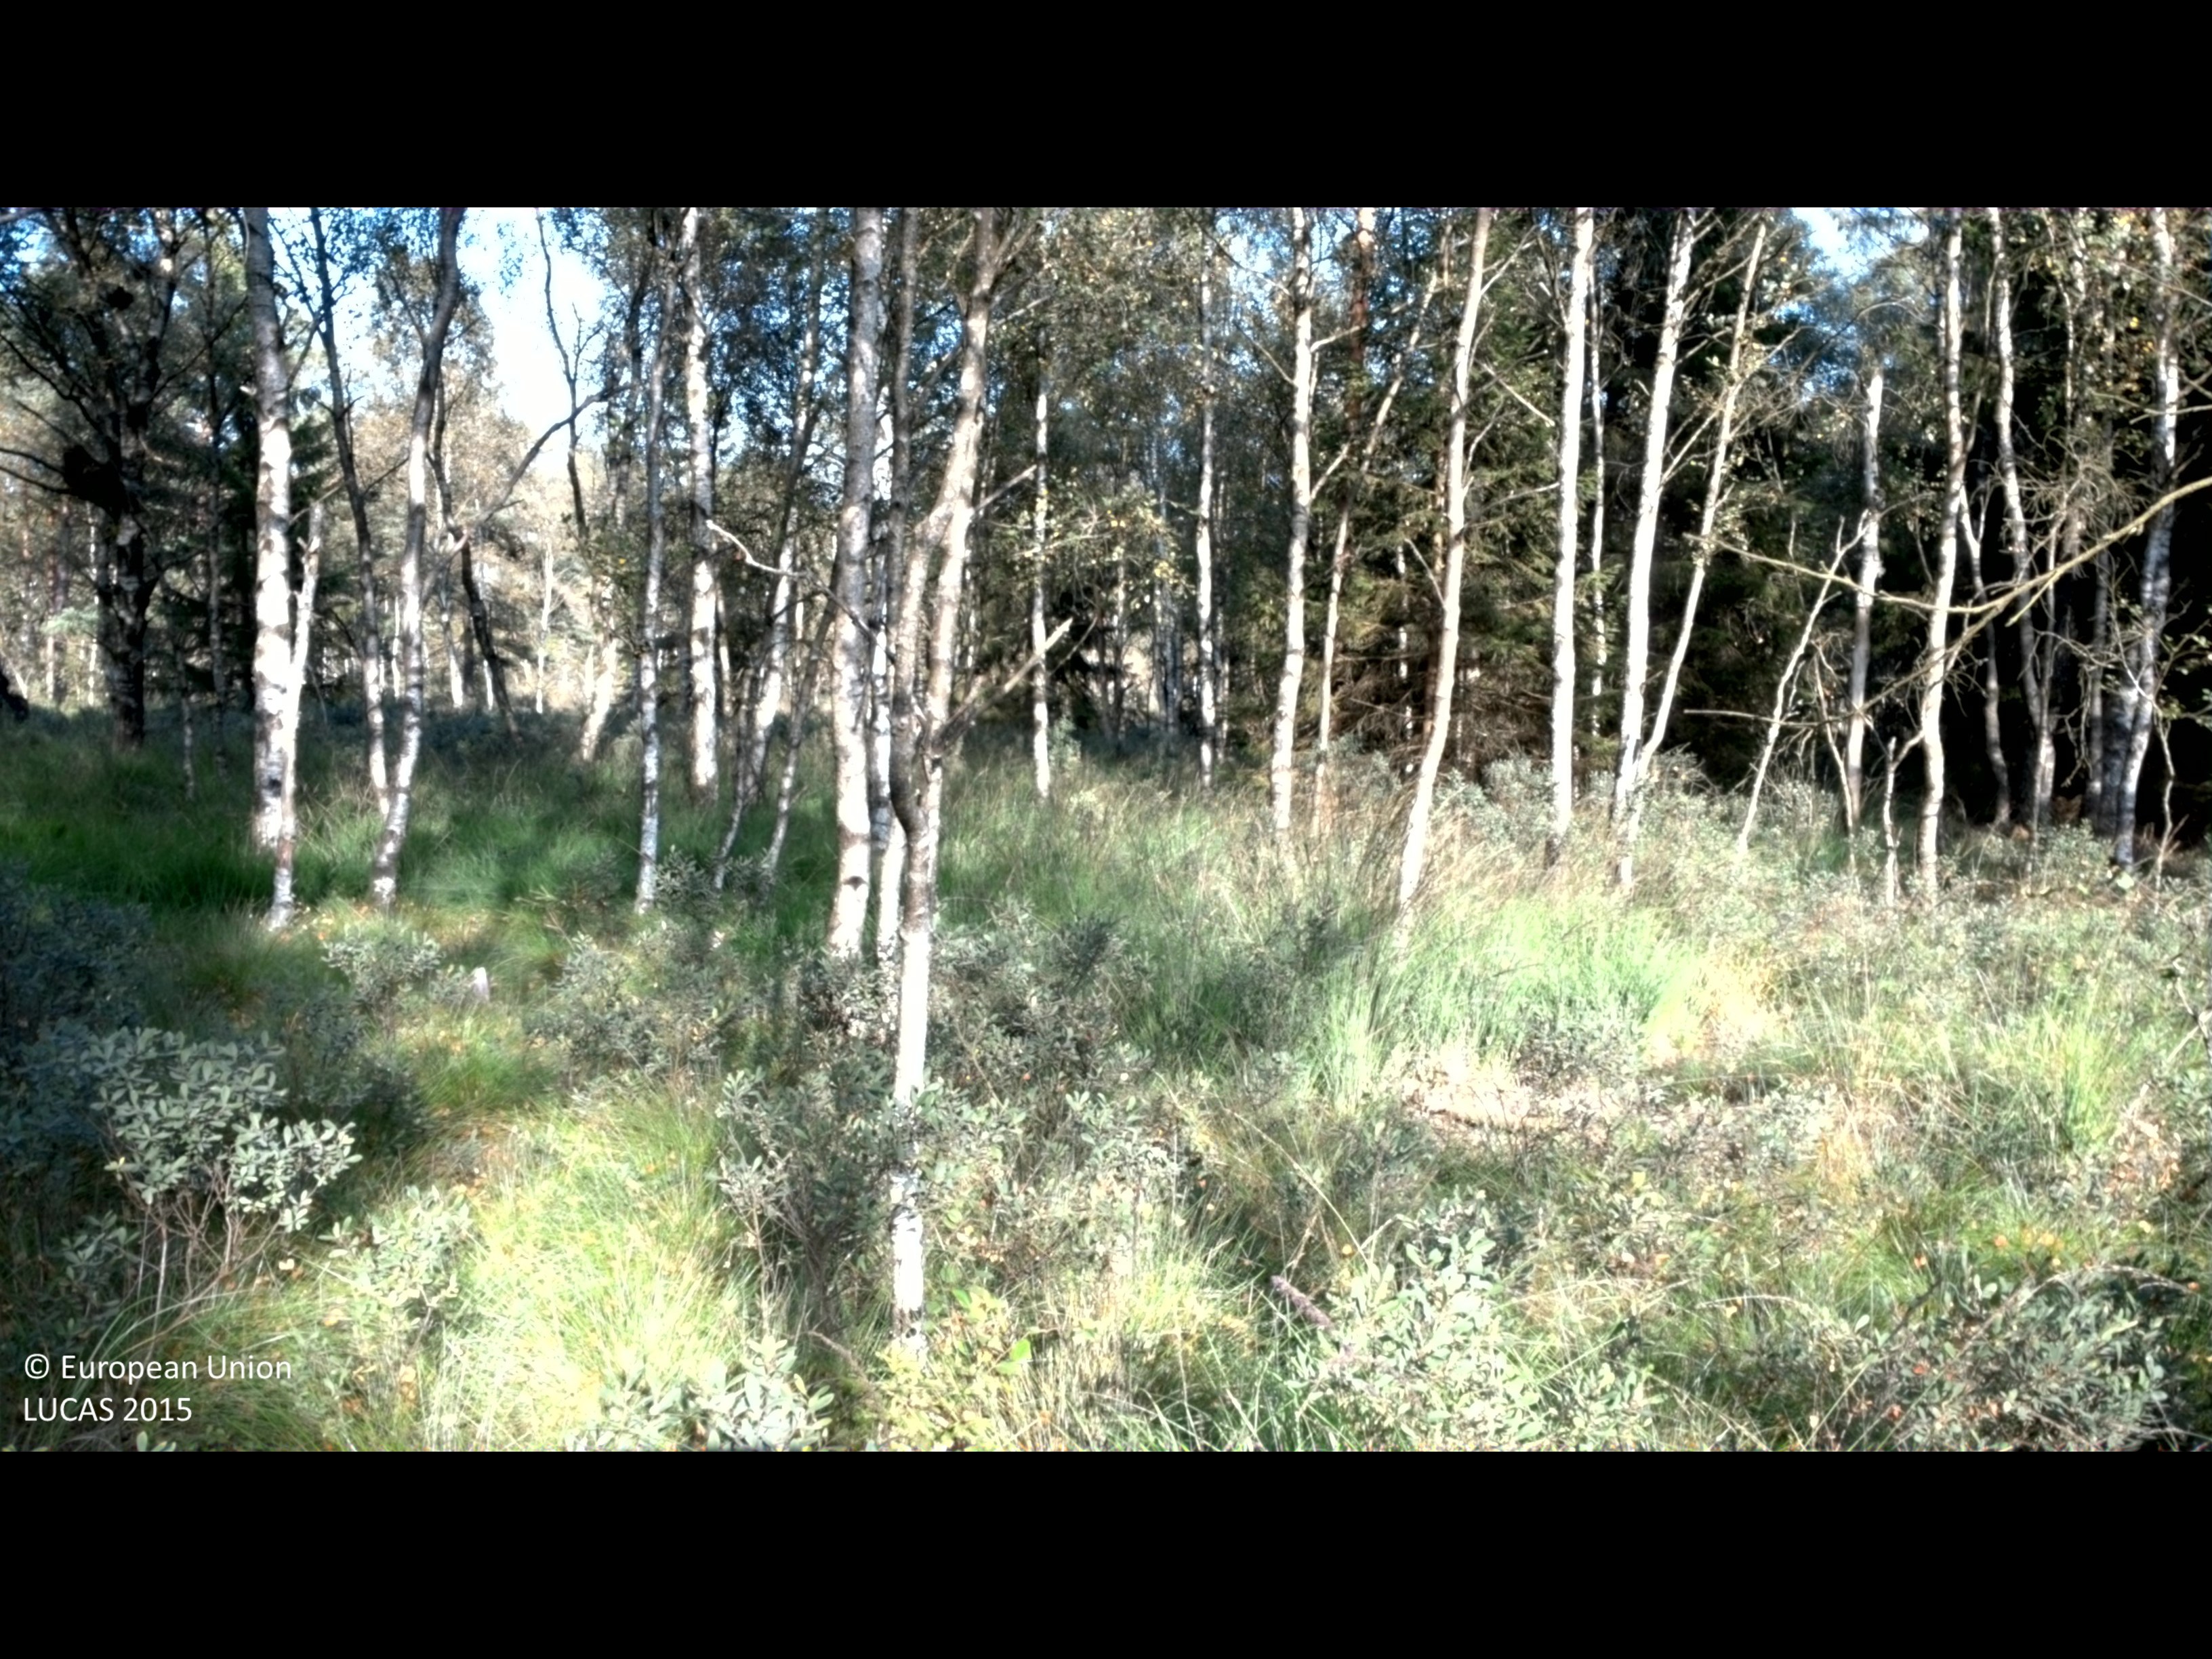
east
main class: Woodland
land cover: Pine dominated mixed woodland
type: boreal forest
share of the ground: 50 - 75 %
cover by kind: broadleaved forest trees 40 %, shrubs 25 %, herbaceous plants 20 %, coniferous forest trees 15 %
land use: Semi-natural and natural areas not in use
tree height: > 5 m
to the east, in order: Pine dominated mixed woodland; Spruce dominated mixed woodland; Broadleaved woodland; Pine dominated mixed woodland; Grassland with sparse tree/shrub cover; Broadleaved woodland; Spruce dominated mixed woodland
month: August
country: SE
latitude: 56.7233
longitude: 13.2160
